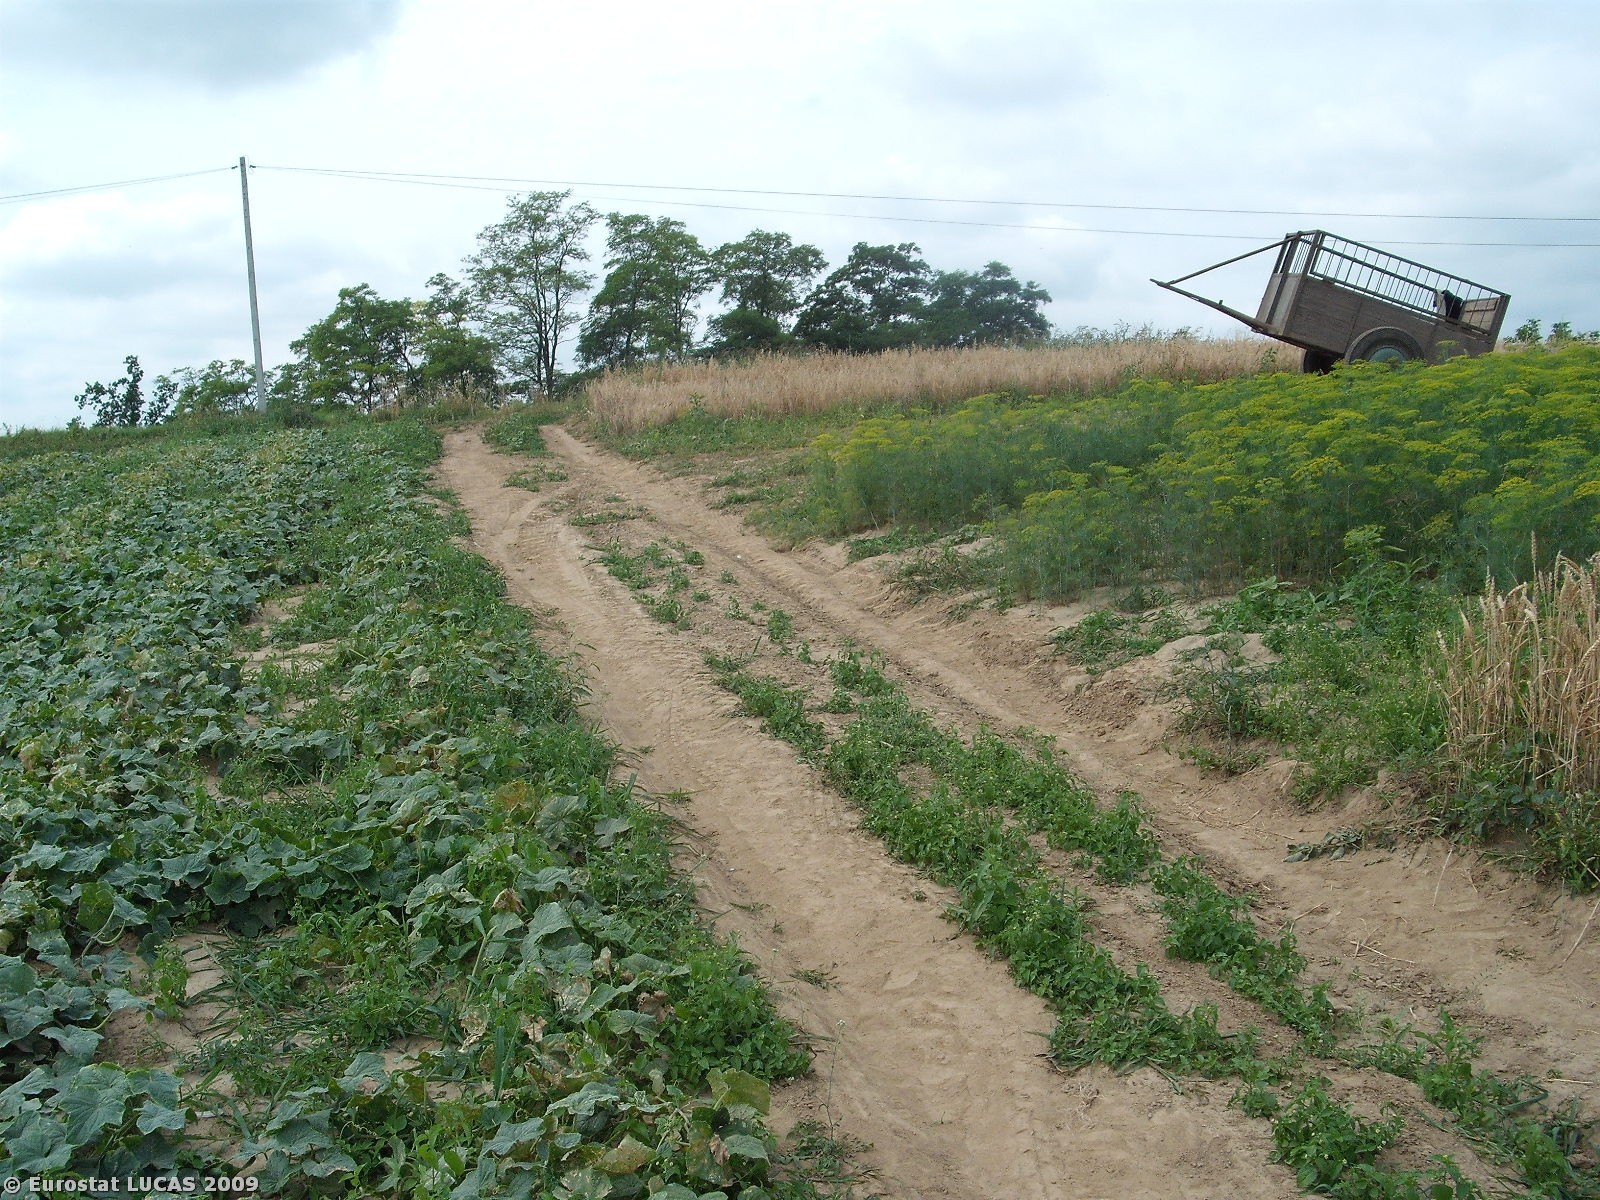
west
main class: Cropland
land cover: Other fresh vegetables
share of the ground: > 75 %
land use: Agriculture (excluding fallow land and kitchen gardens)
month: August
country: PL
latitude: 50.2280
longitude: 20.6510
